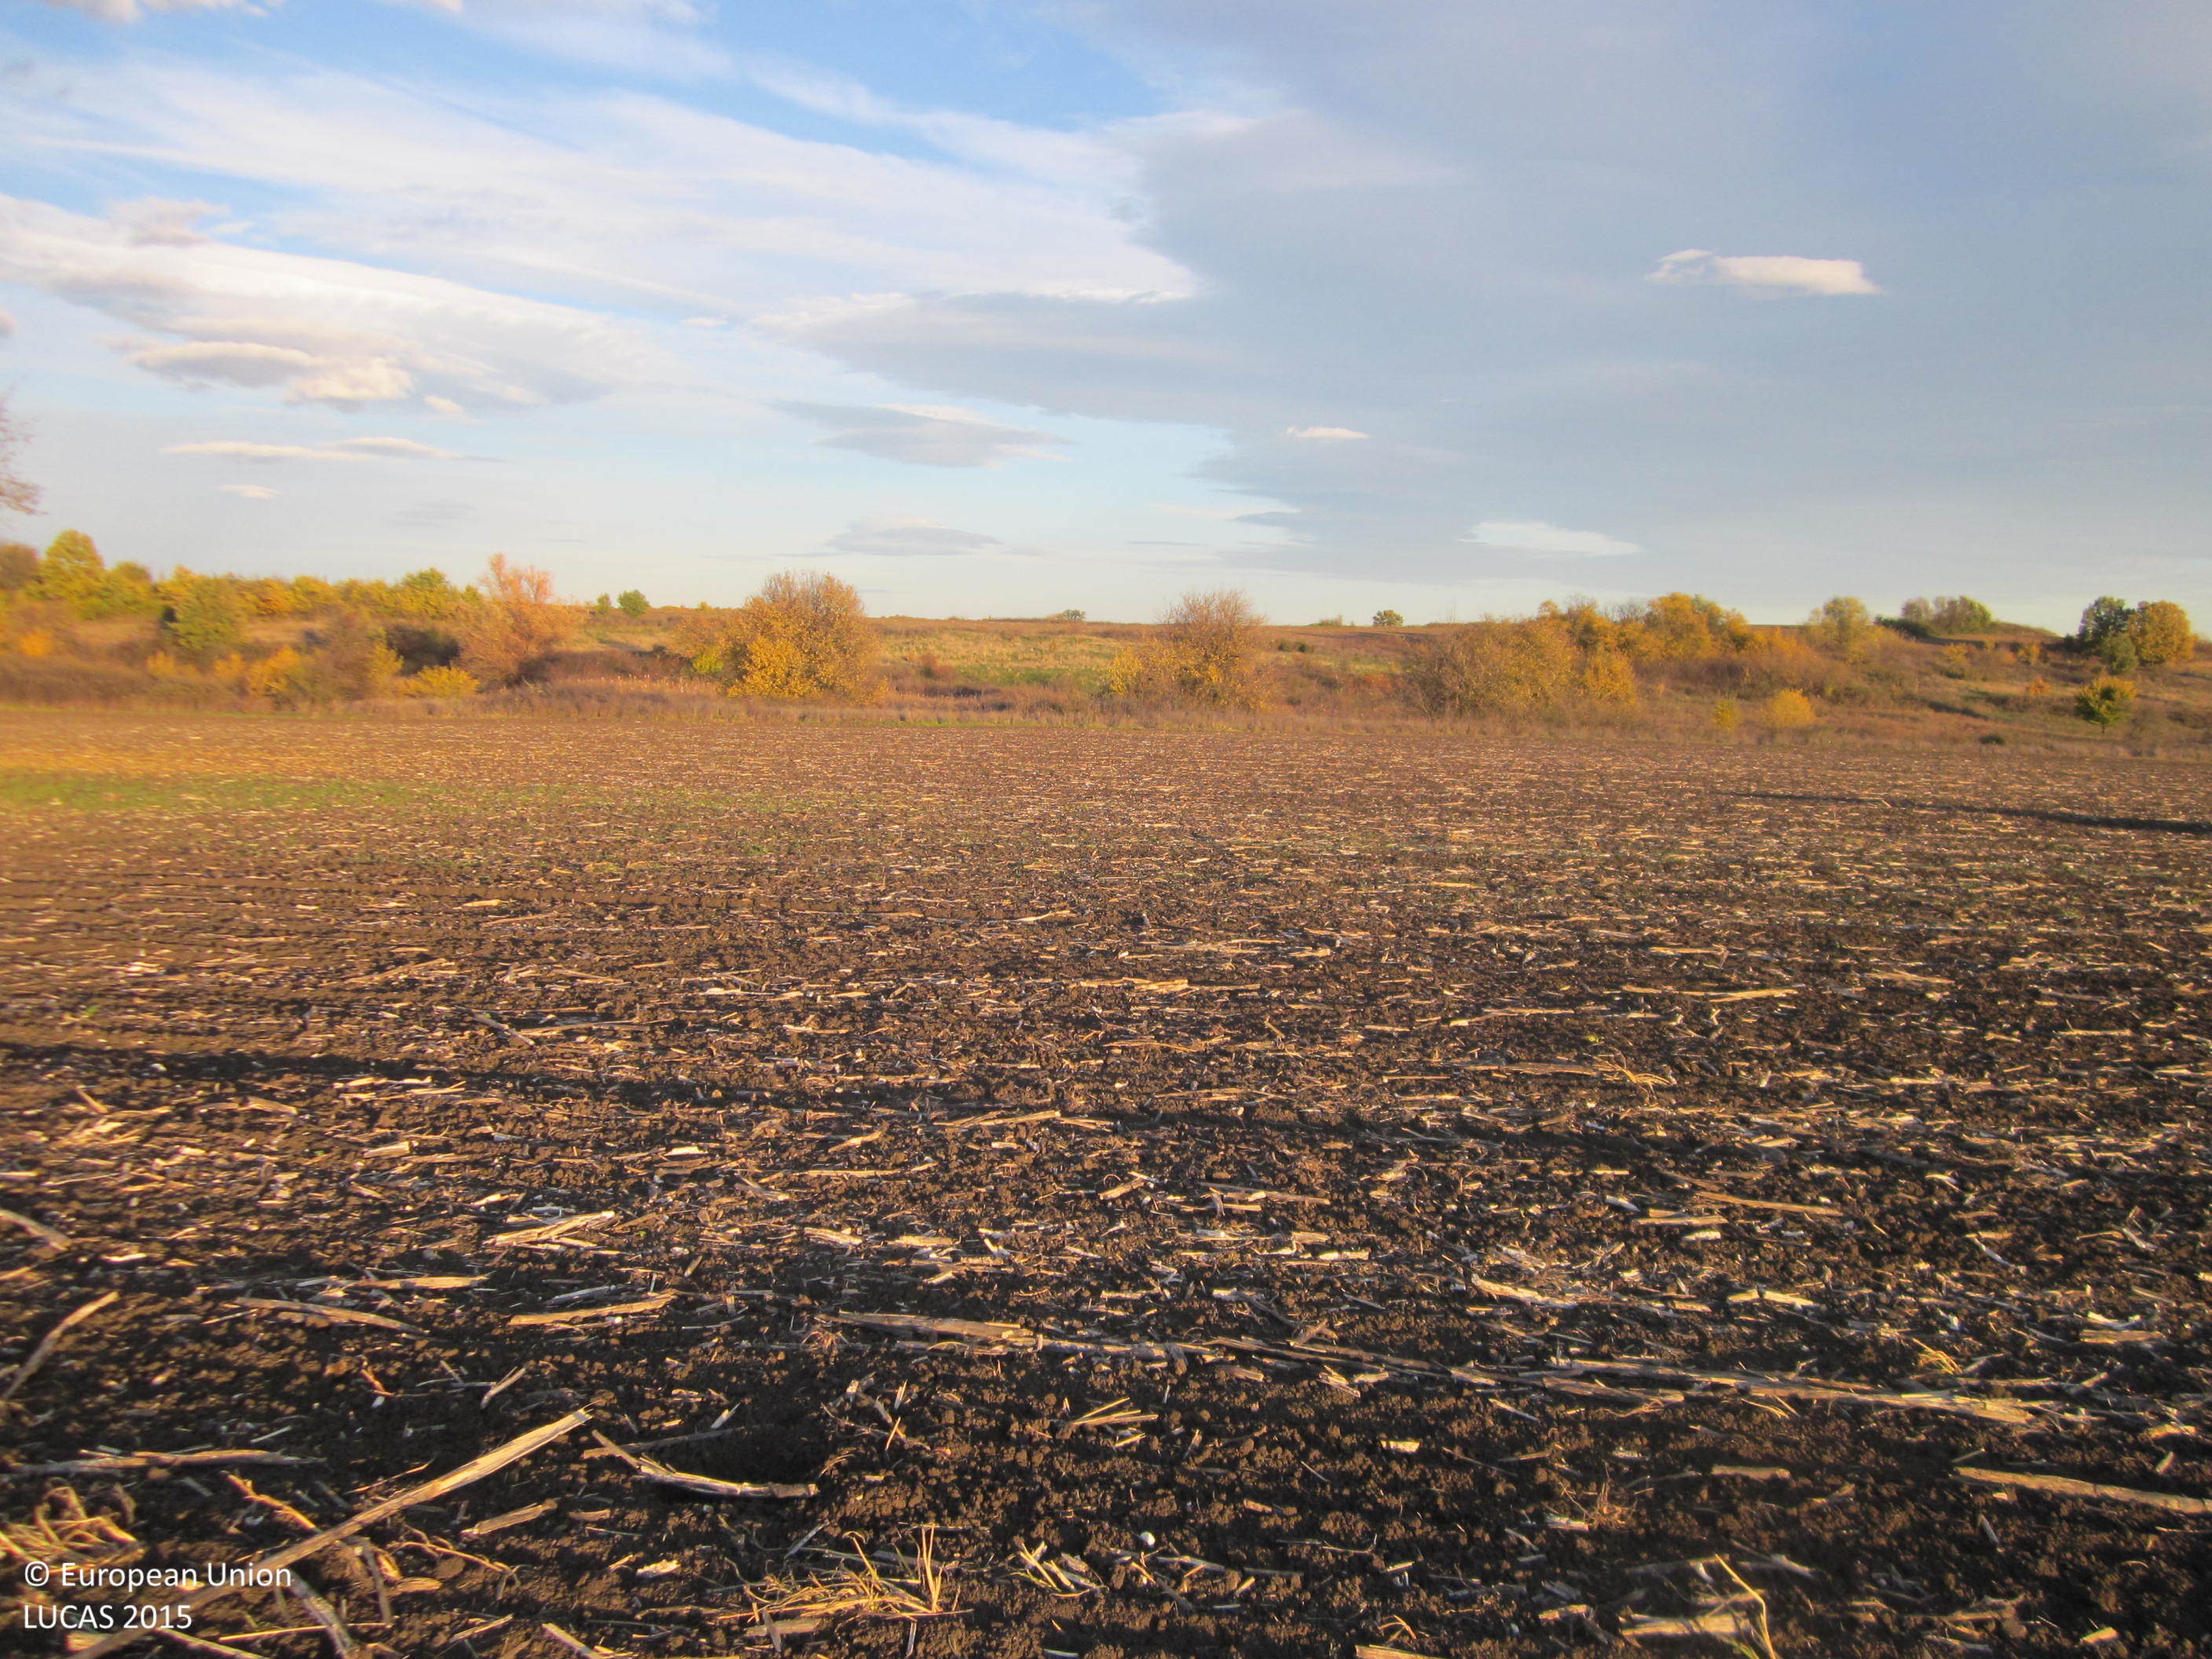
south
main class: Cropland
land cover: Sunflower
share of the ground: < 10 %
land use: Agriculture (excluding fallow land and kitchen gardens)
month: November
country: BG
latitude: 42.3932
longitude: 24.6172
